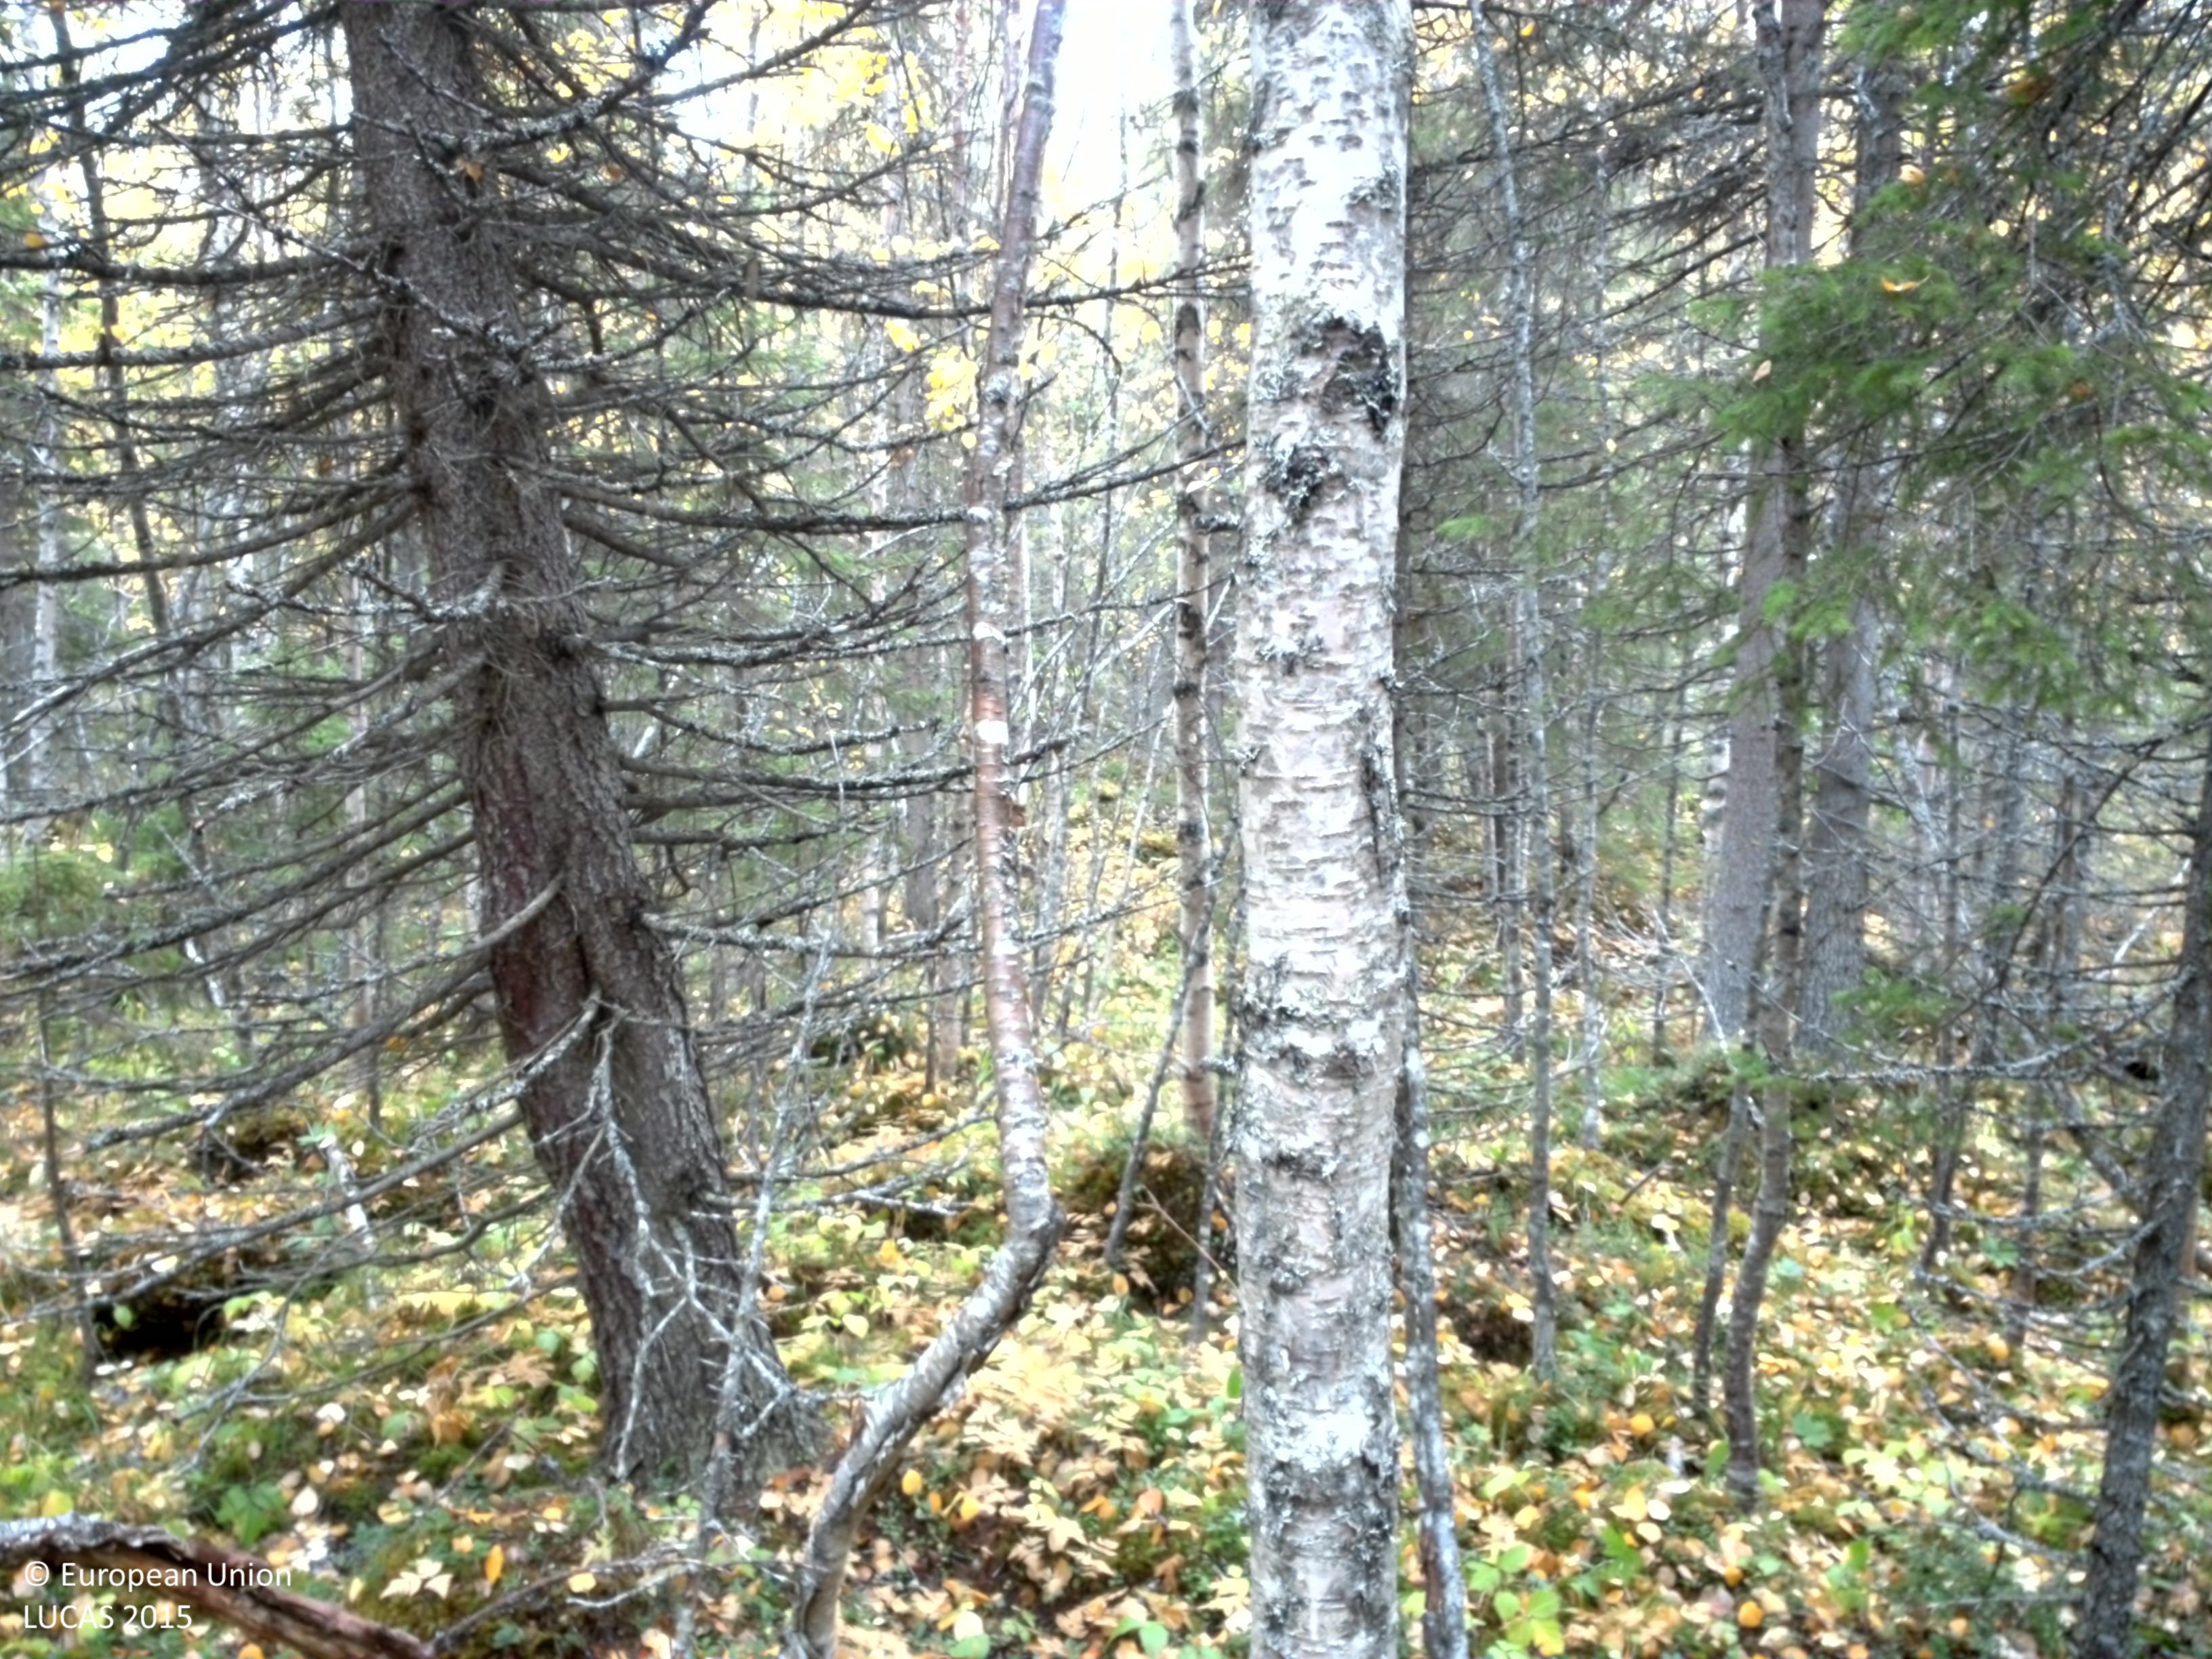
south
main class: Woodland
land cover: Spruce dominated mixed woodland
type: boreal forest
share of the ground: 50 - 75 %
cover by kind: coniferous forest trees 35 %, broadleaved forest trees 25 %, herbaceous plants 20 %, shrubs 10 %, lichens and mosses 10 %
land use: Forestry
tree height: > 5 m
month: September
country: SE
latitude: 65.3639
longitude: 16.2194
